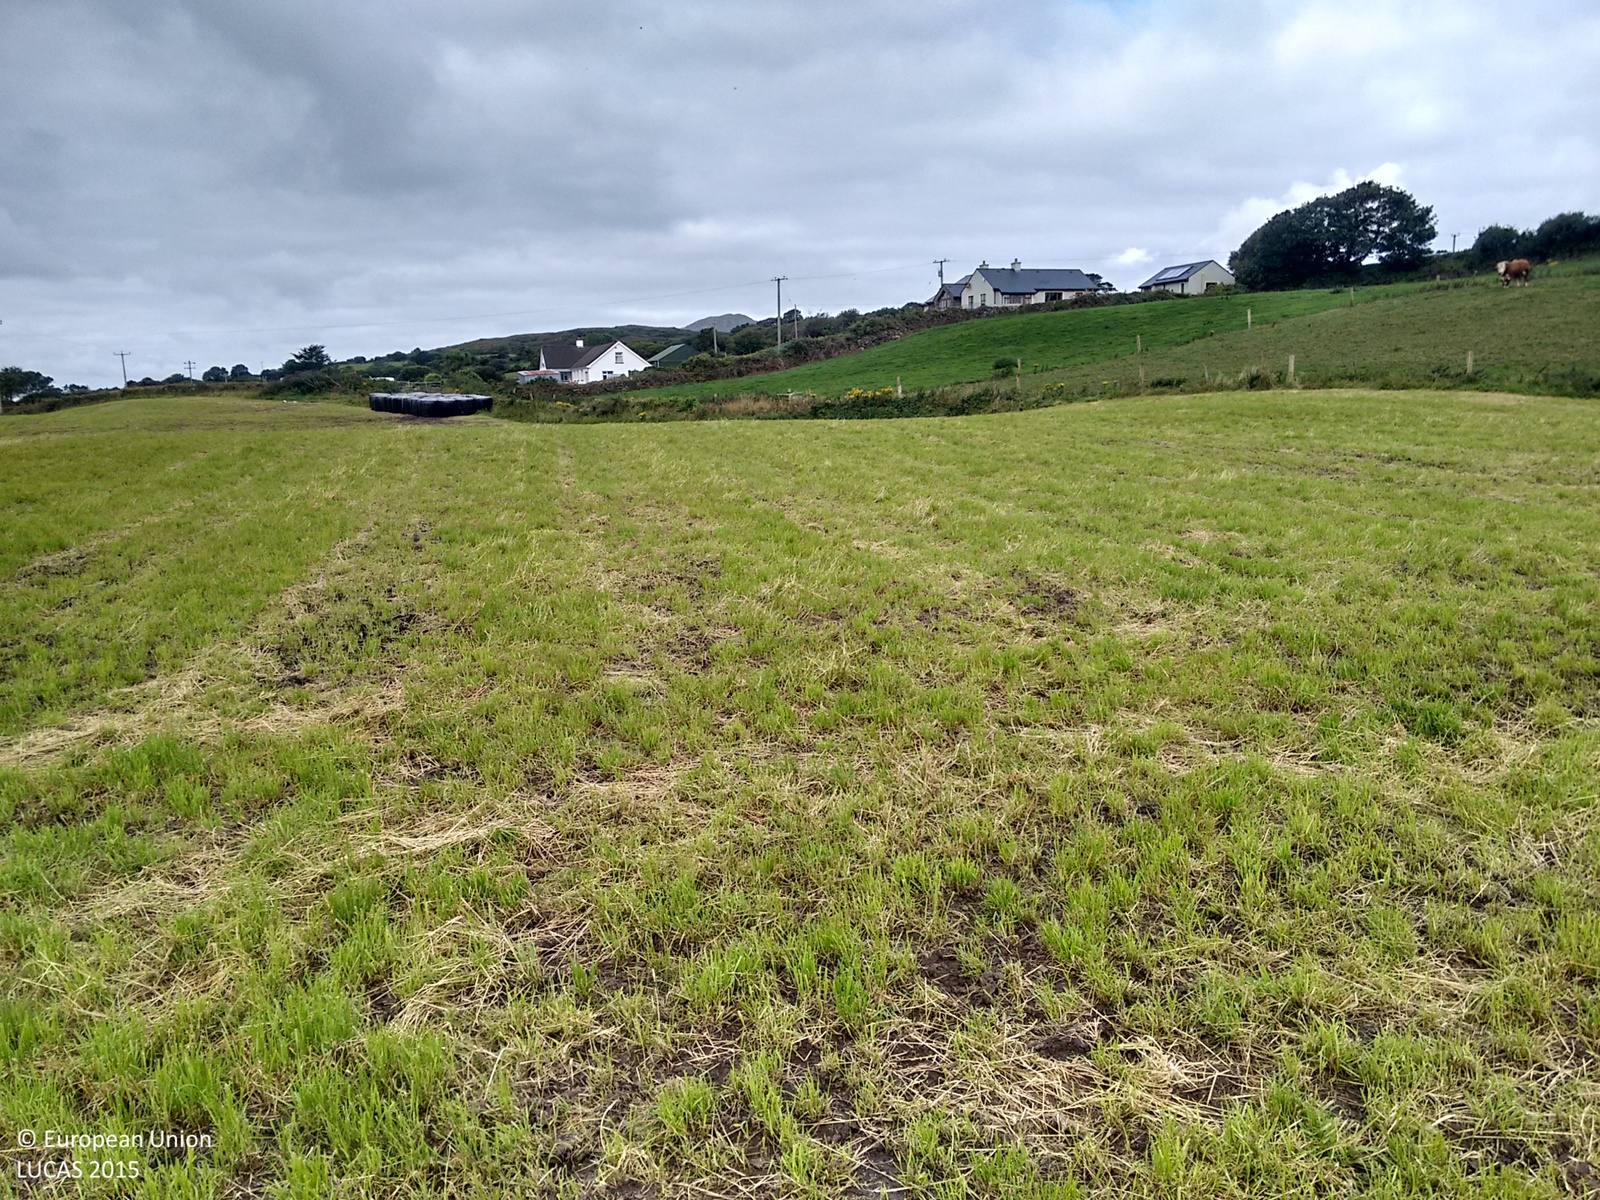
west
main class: Grassland
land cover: Grassland without tree/shrub cover
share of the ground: > 75 %
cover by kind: herbaceous plants 95 %, shrubs 5 %
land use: Agriculture (excluding fallow land and kitchen gardens)
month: August
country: IE
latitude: 51.6086
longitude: -9.6008
